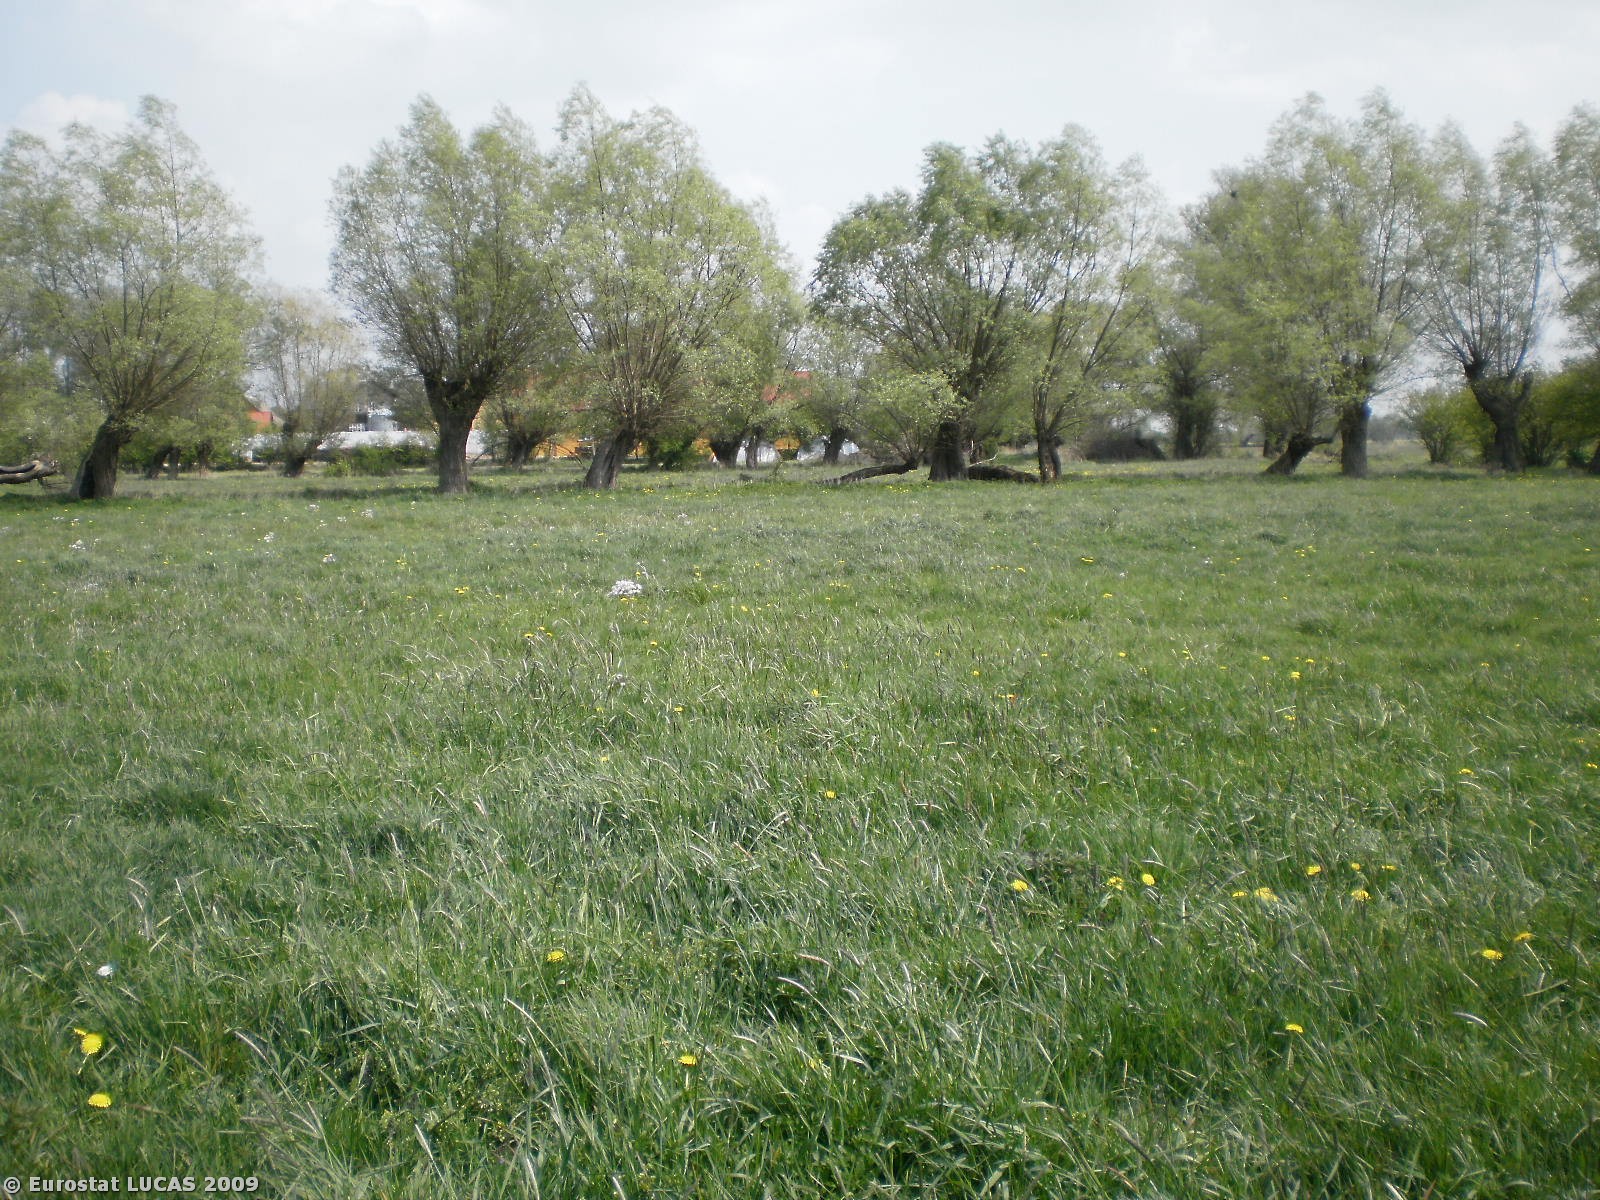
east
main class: Grassland
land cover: Grassland without tree/shrub cover
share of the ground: > 75 %
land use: Agriculture (excluding fallow land and kitchen gardens)
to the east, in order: Grassland without tree/shrub cover; Lines of trees; Ditches and canals; Grassland without tree/shrub cover; Lines of trees; Ditches and canals; Lines of trees; Potatoes; Oats; Electric lines; Oats; Grass margins; Abandoned hedges; Grass margins; Artificial constructions in urban areas
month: May
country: PL
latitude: 54.3315
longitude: 19.0175
